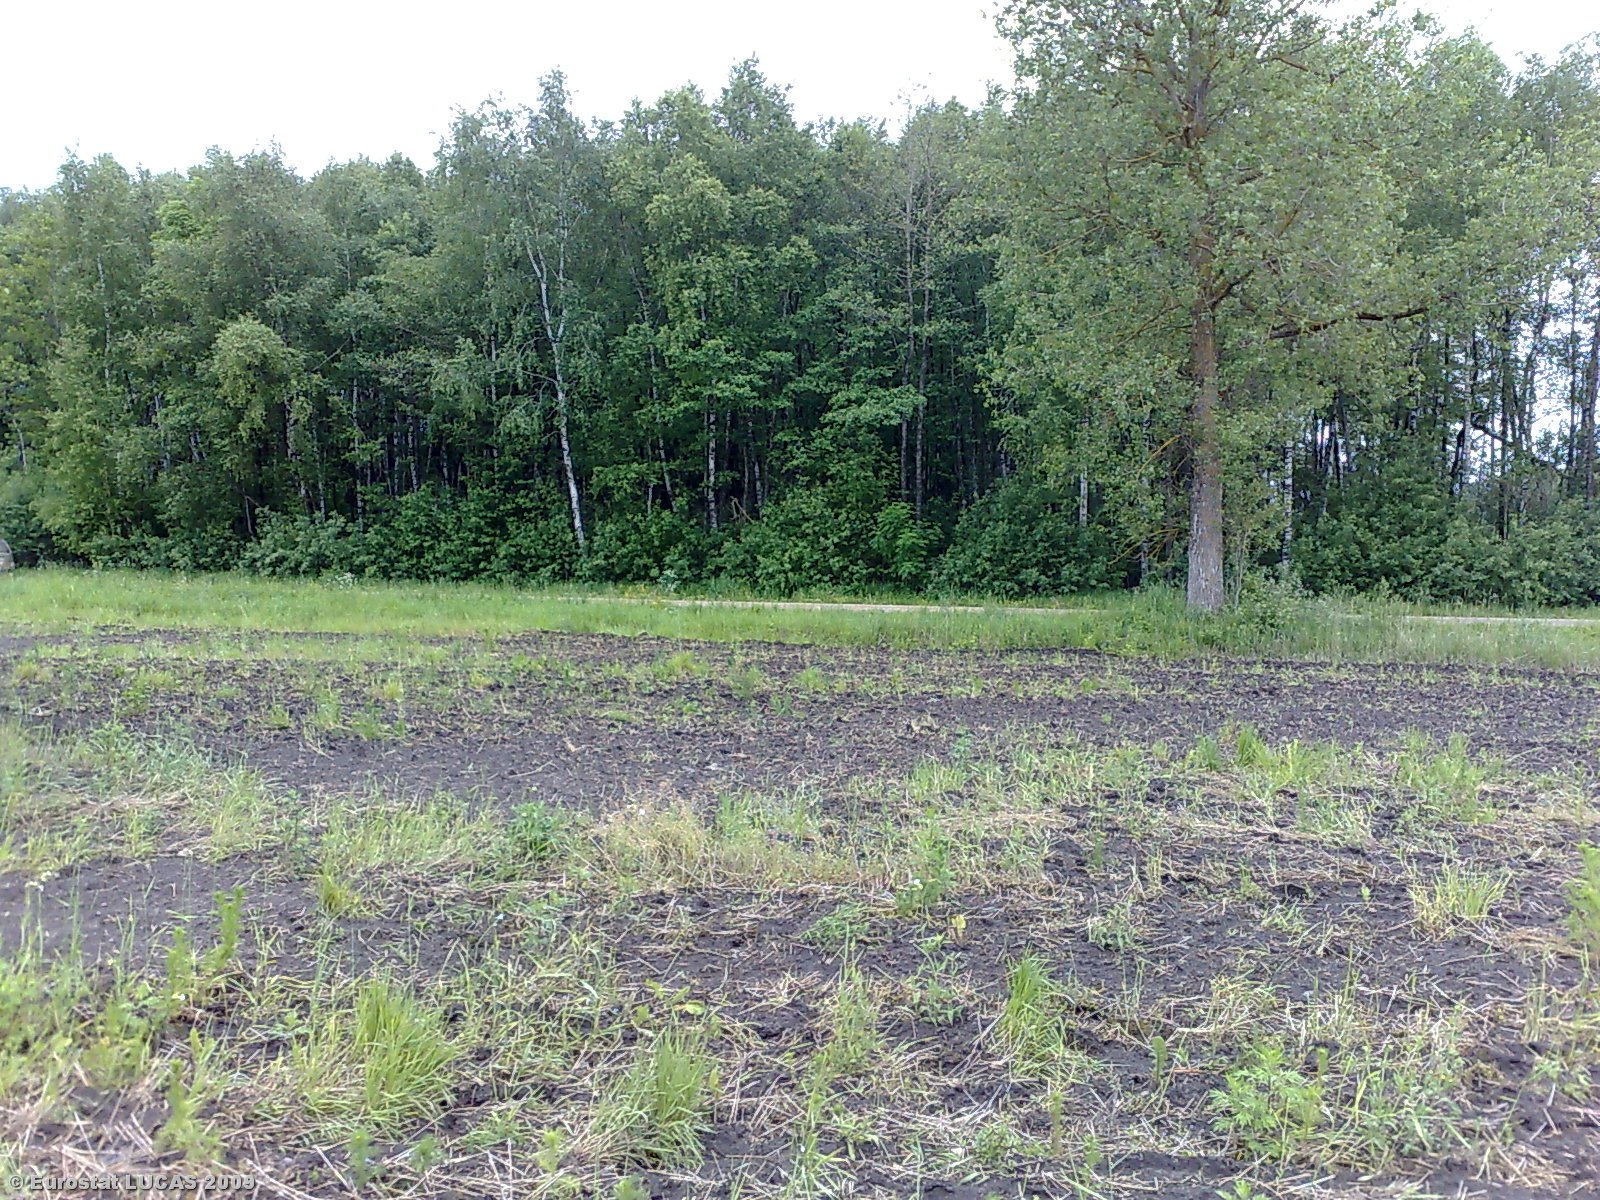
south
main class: Grassland
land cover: Spontaneously vegetated surfaces
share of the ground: 10 - 25 %
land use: Fallow land
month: June
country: LT
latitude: 55.9239
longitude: 24.0270
